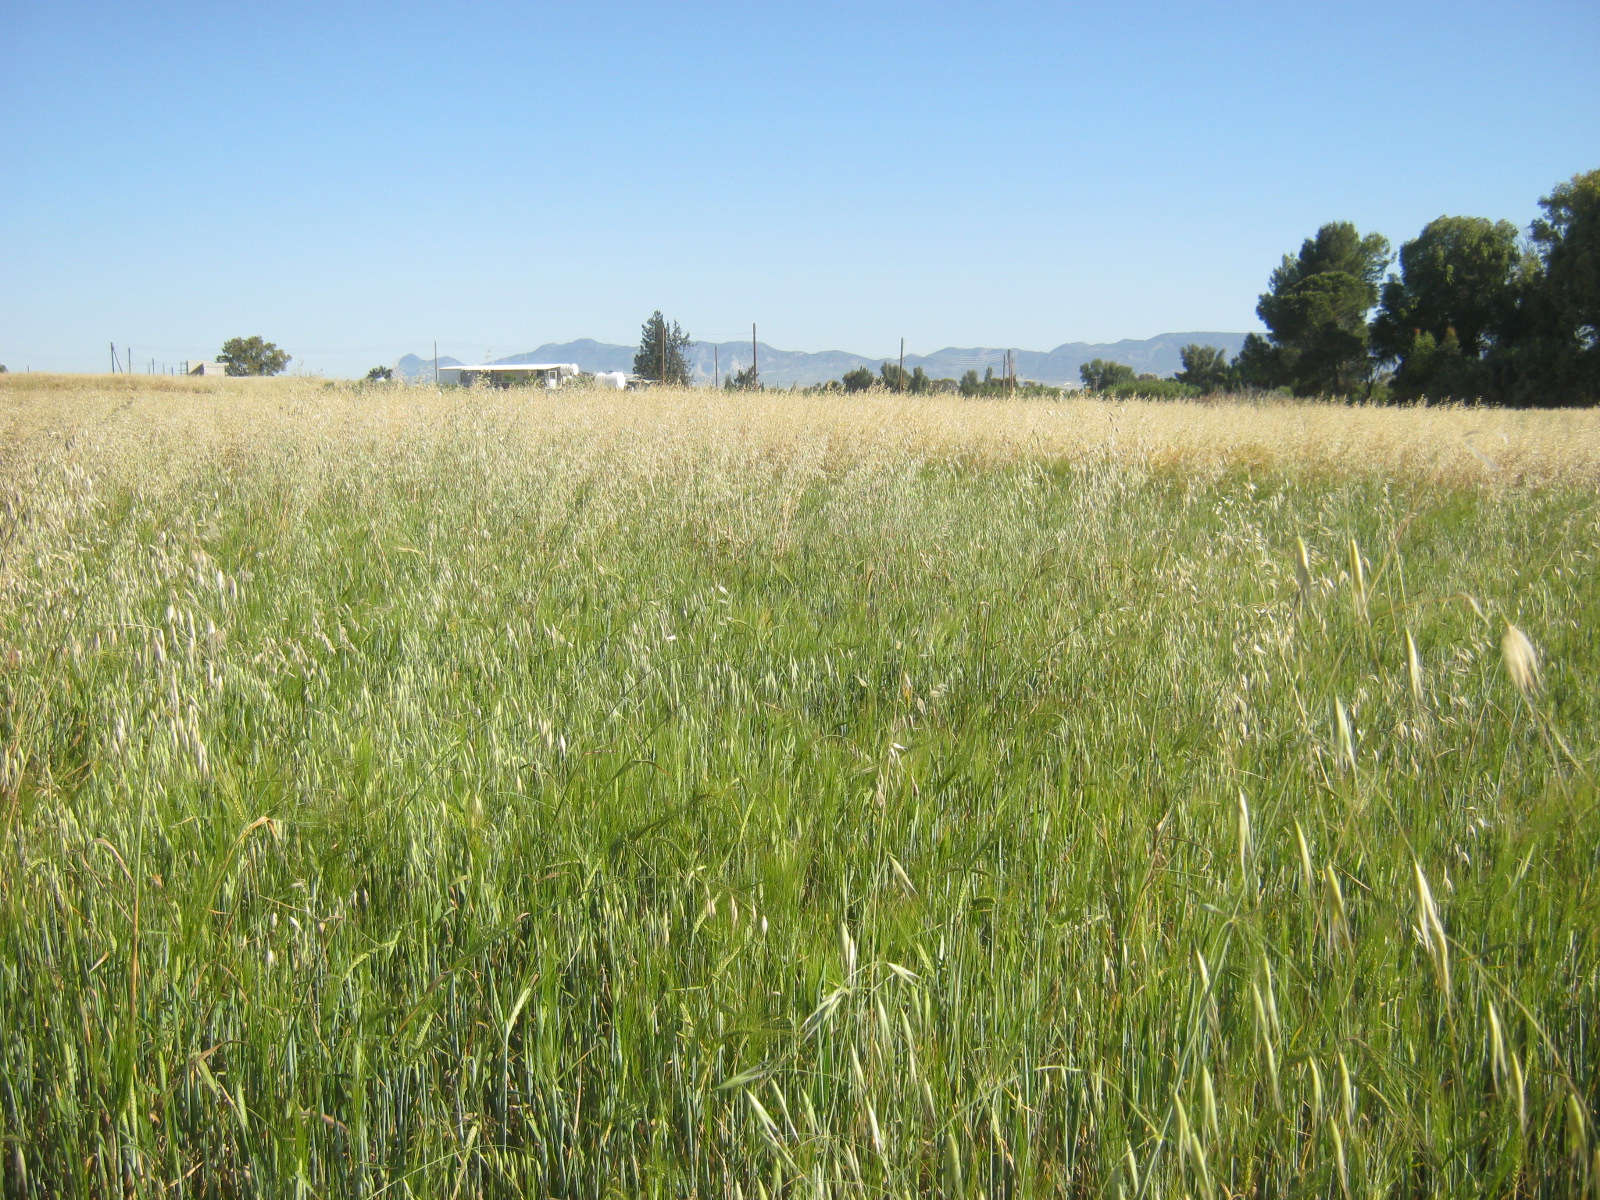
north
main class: Cropland
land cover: Common wheat
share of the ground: > 75 %
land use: Agriculture (excluding fallow land and kitchen gardens)
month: May
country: CY
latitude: 35.1428
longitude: 33.2488
